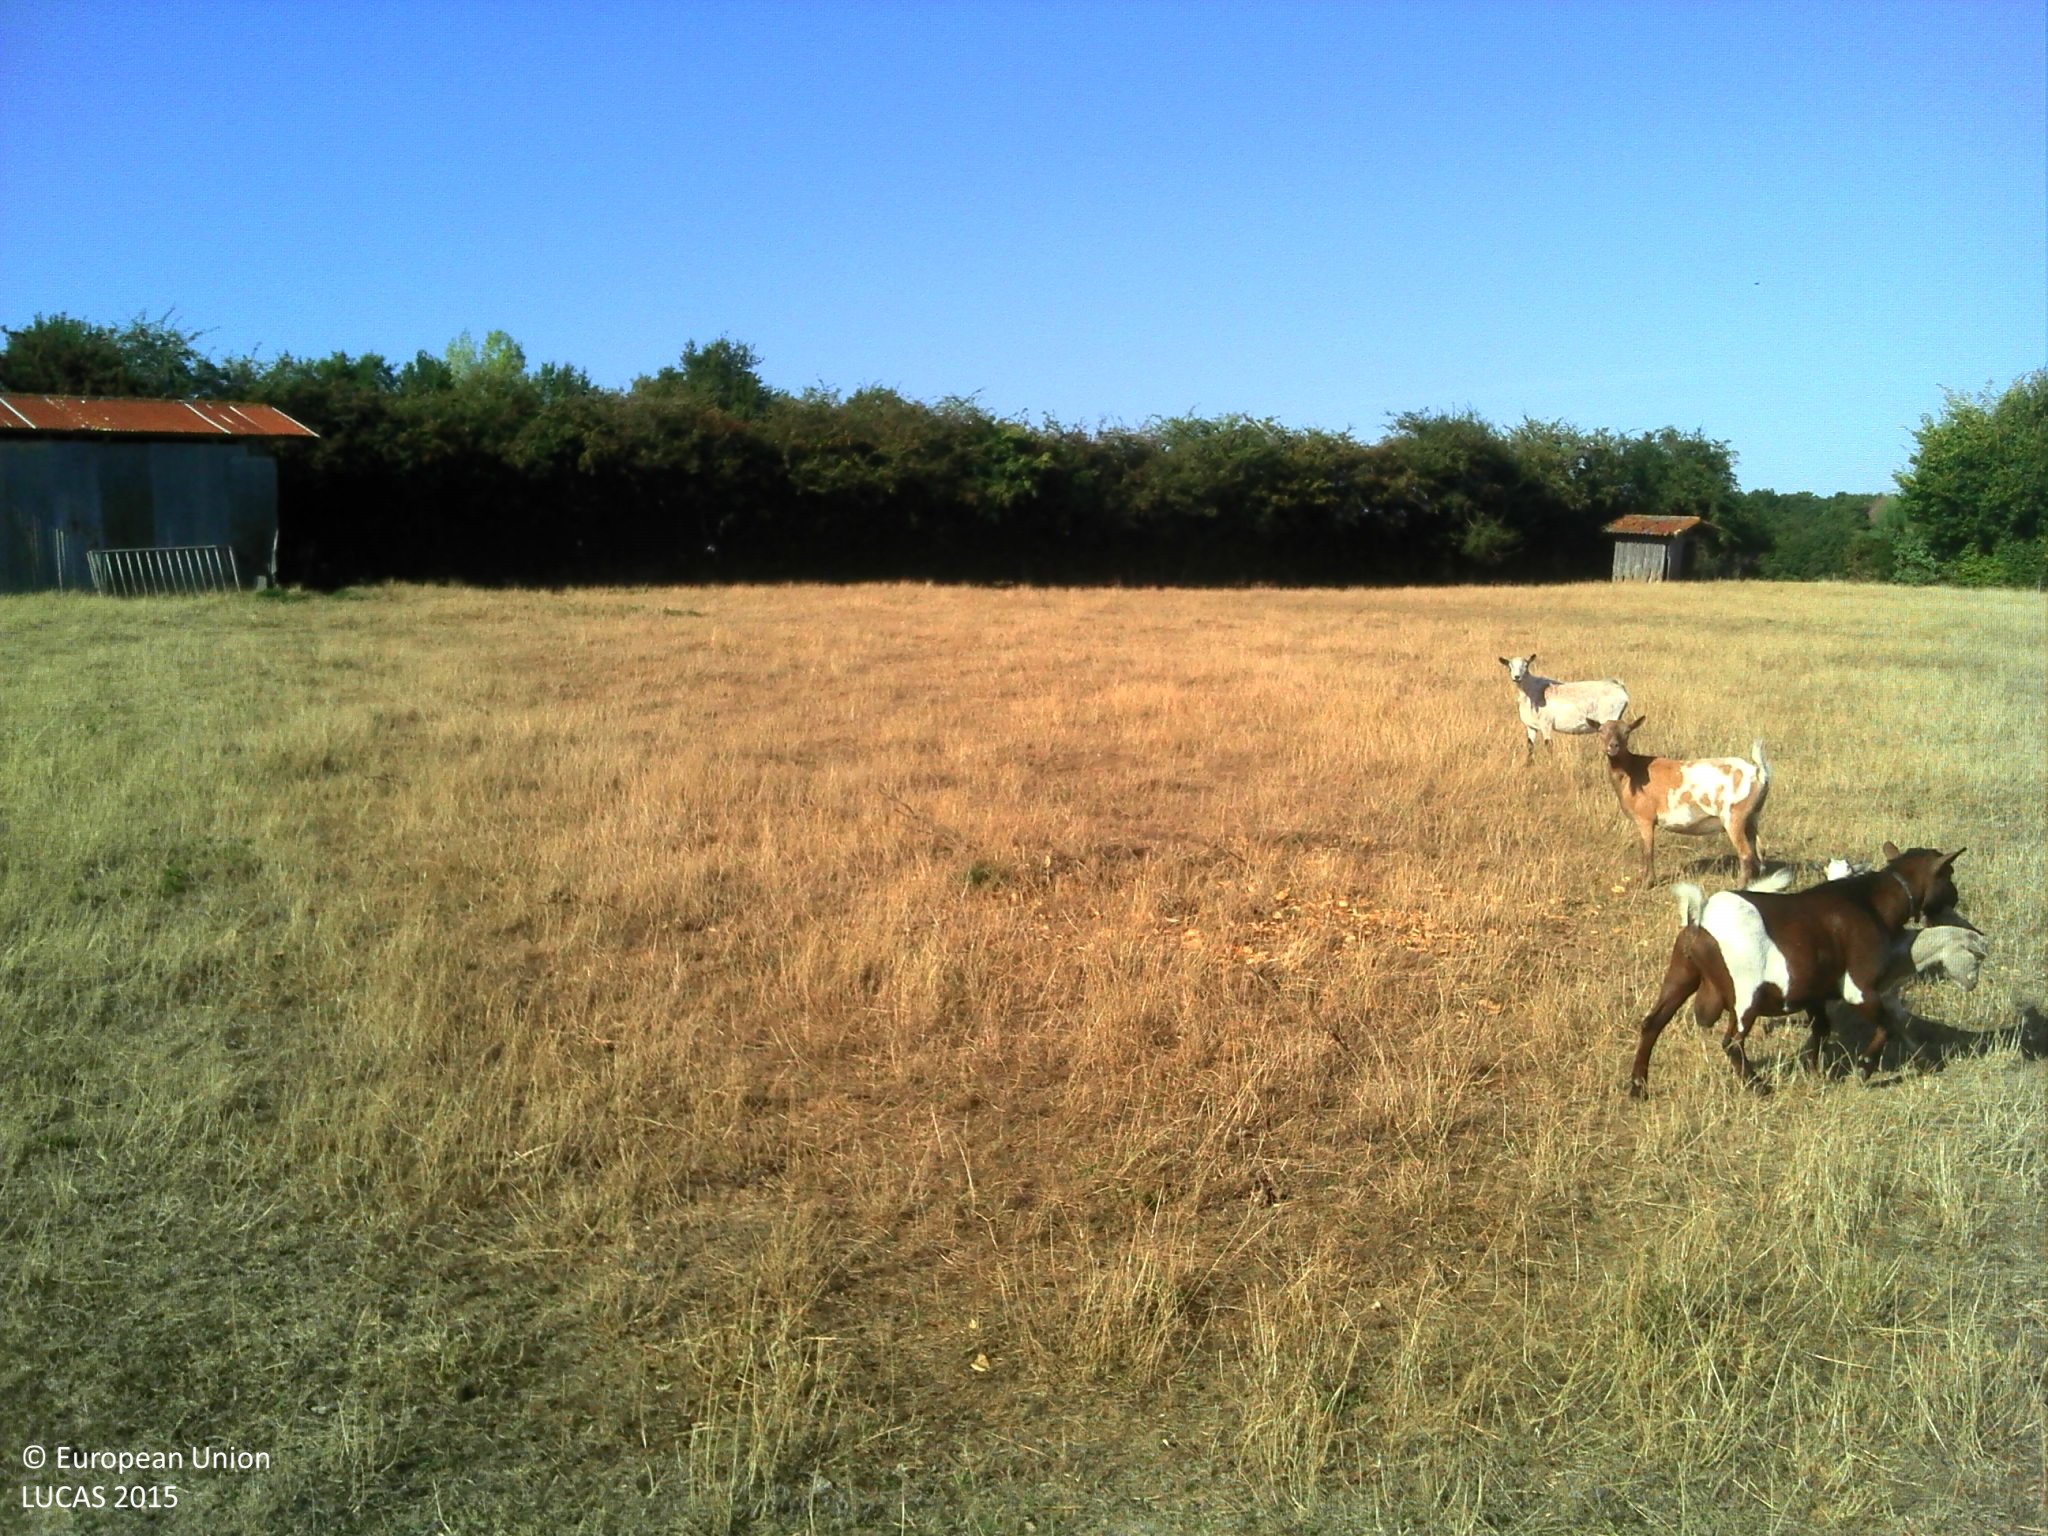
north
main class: Grassland
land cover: Grassland without tree/shrub cover
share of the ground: > 75 %
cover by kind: herbaceous plants 95 %, shrubs 5 %
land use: Residential
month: August
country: FR
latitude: 46.6767
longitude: -1.1329
